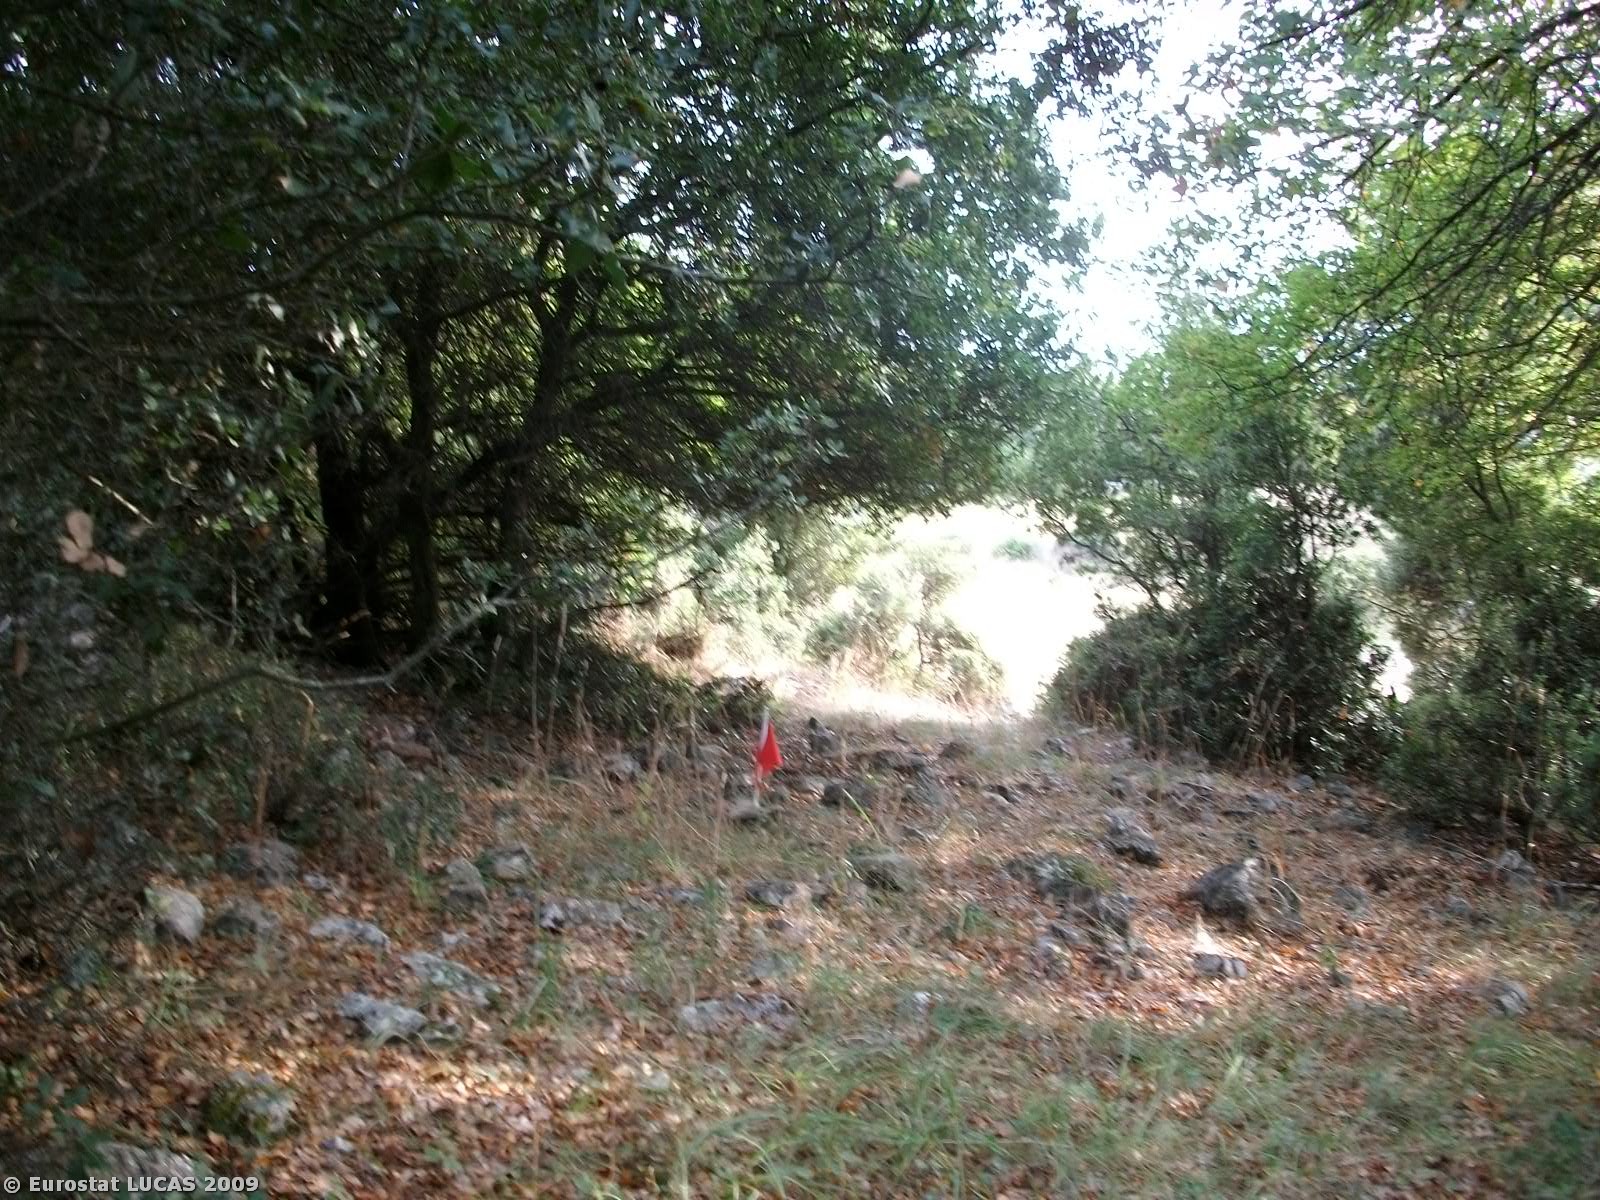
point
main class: Woodland
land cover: Broadleaved woodland
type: broadleaved evergreen forest
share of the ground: 50 - 75 %
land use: Forestry
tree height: > 5 m
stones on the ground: 25 - 50 %
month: September
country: GR
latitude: 41.1160
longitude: 24.4562
